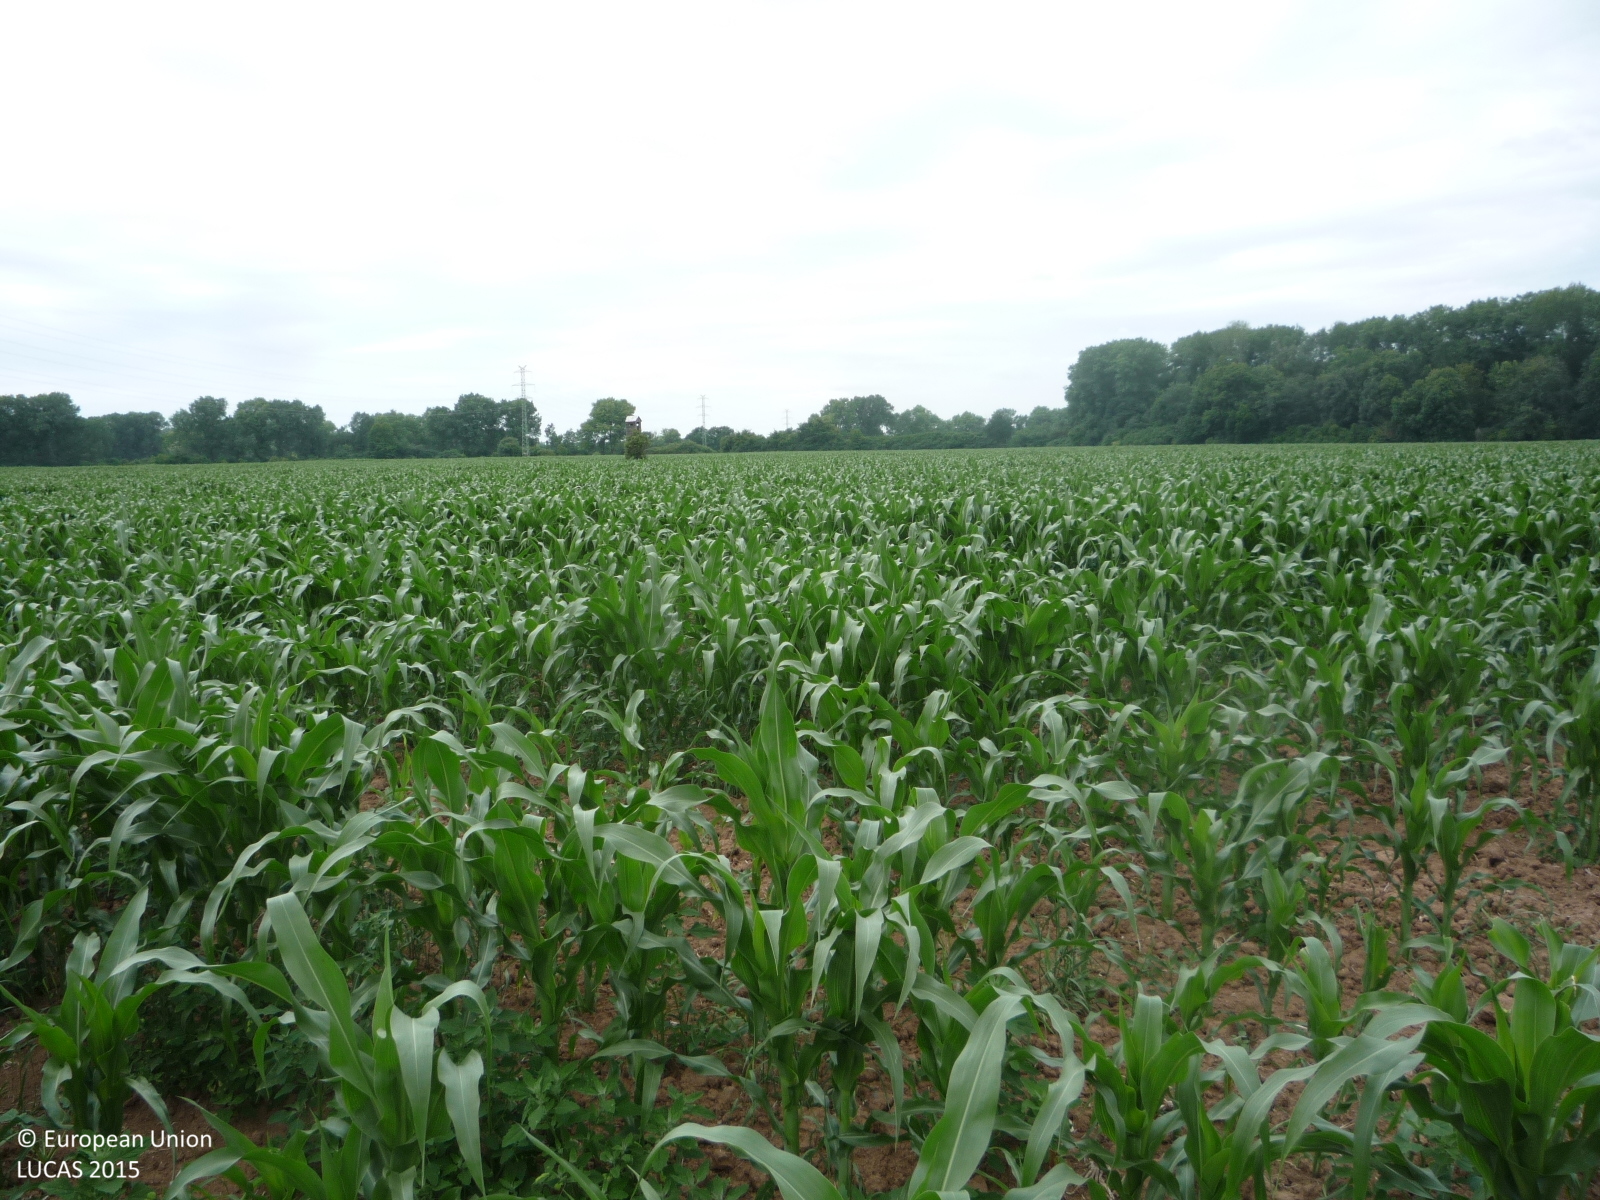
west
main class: Cropland
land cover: Maize
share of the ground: > 75 %
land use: Agriculture (excluding fallow land and kitchen gardens)
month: June
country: CZ
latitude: 50.0675
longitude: 15.1583
